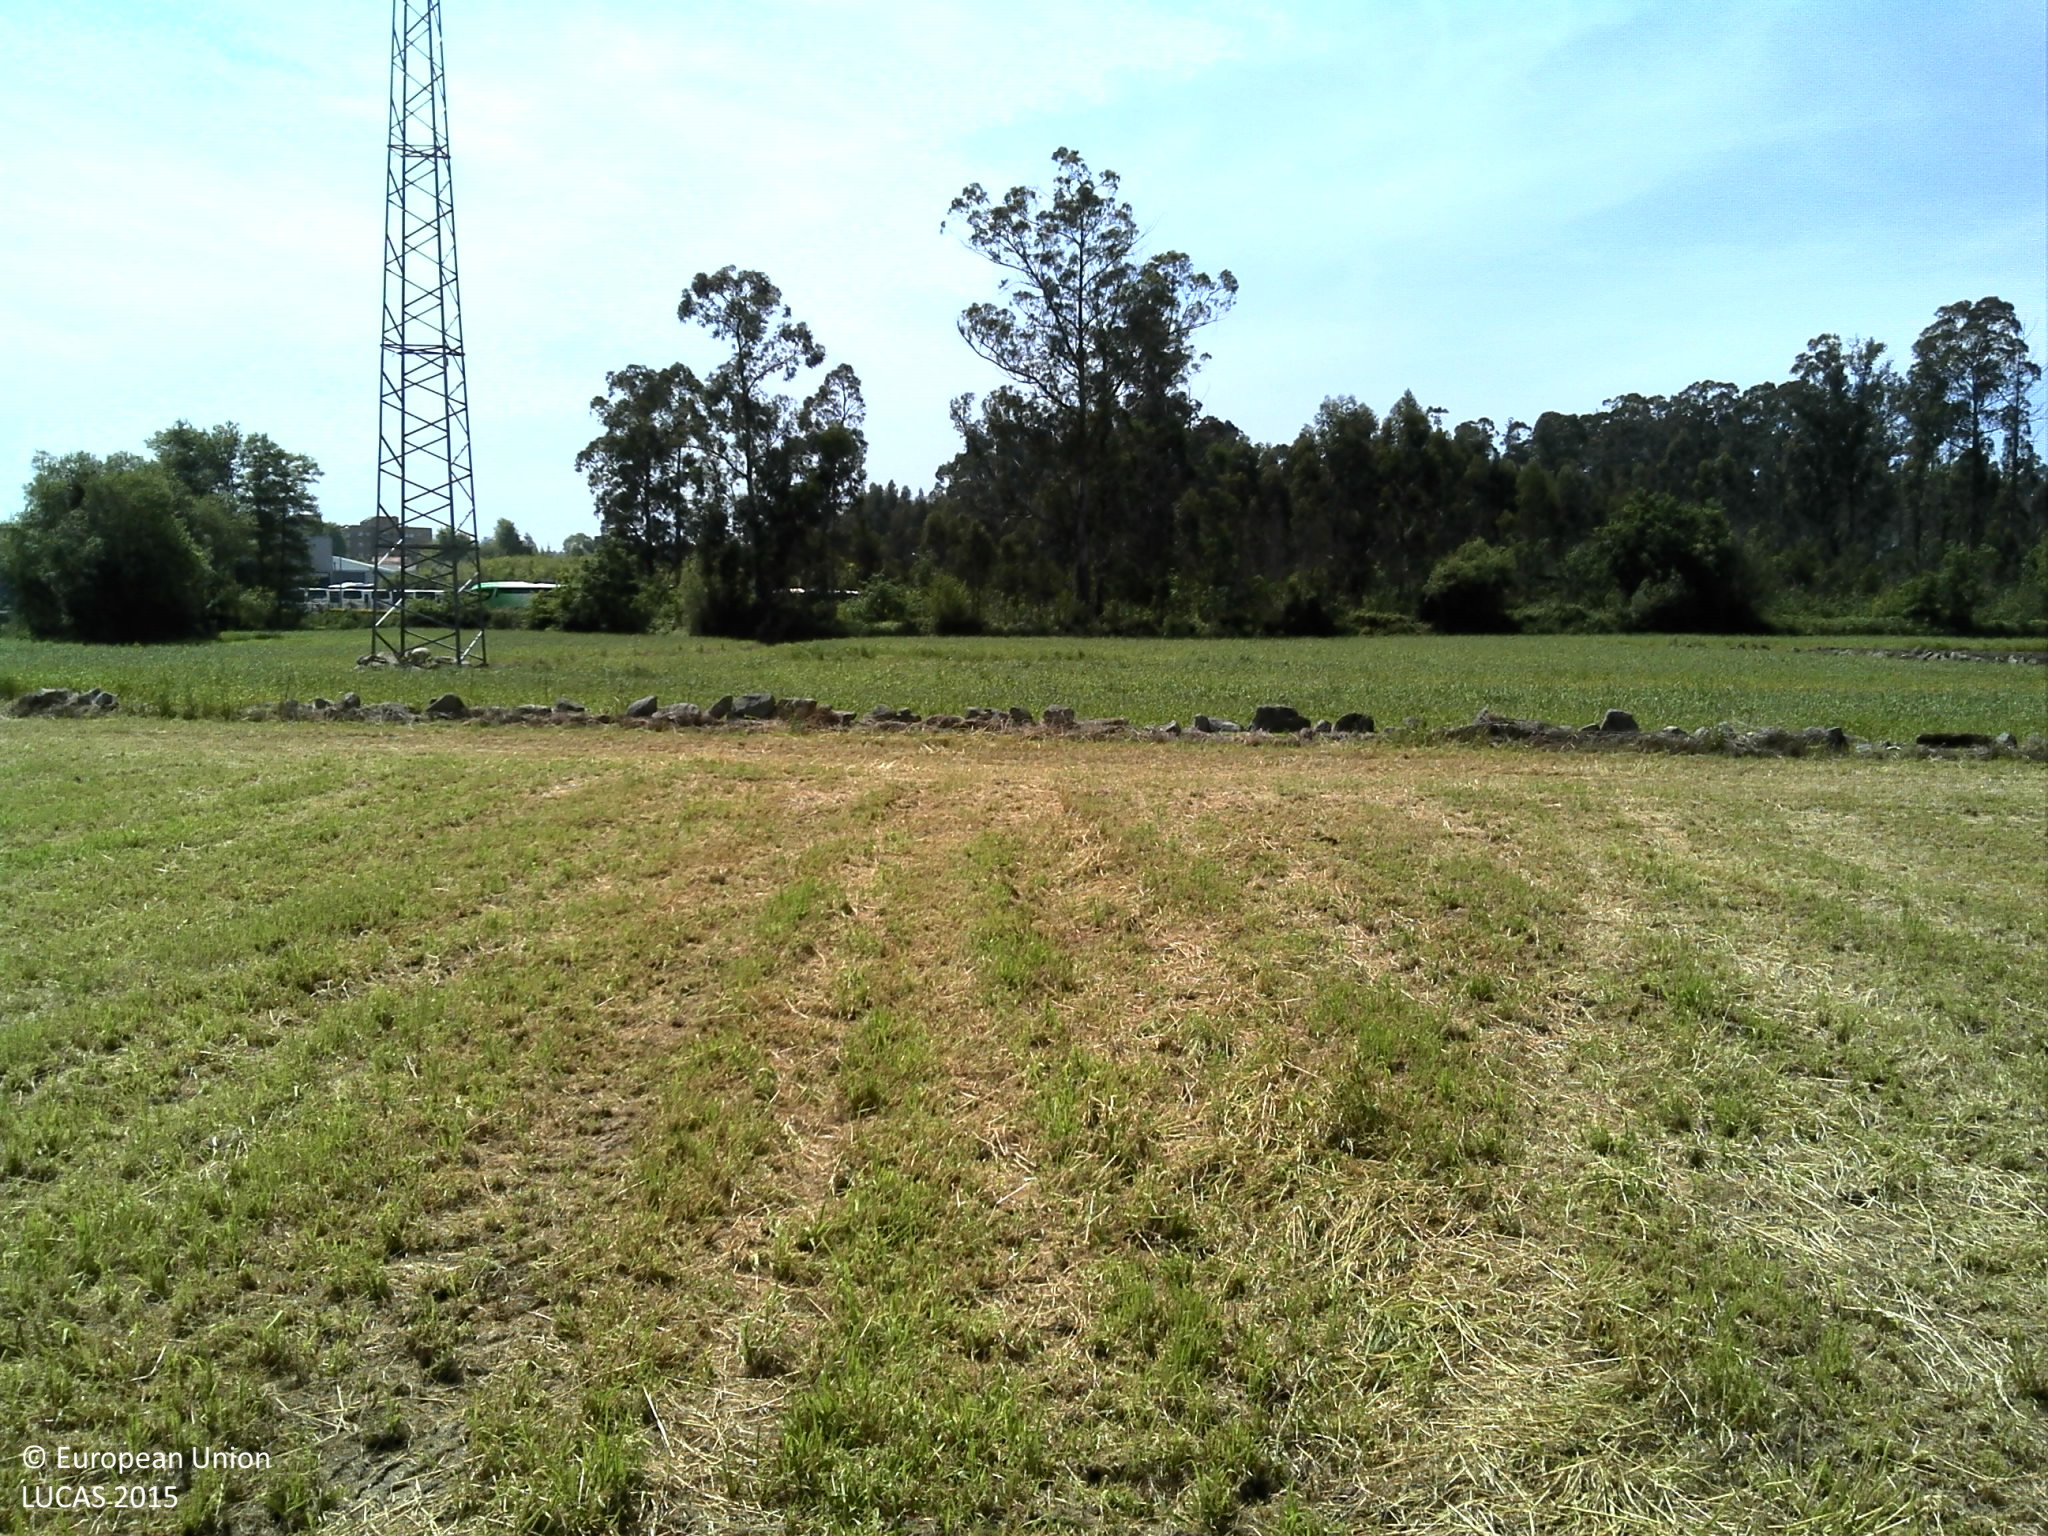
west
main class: Cropland
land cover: Temporary grasslands
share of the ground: > 75 %
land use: Agriculture (excluding fallow land and kitchen gardens)
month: May
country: PT
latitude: 41.2476
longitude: -8.5906
